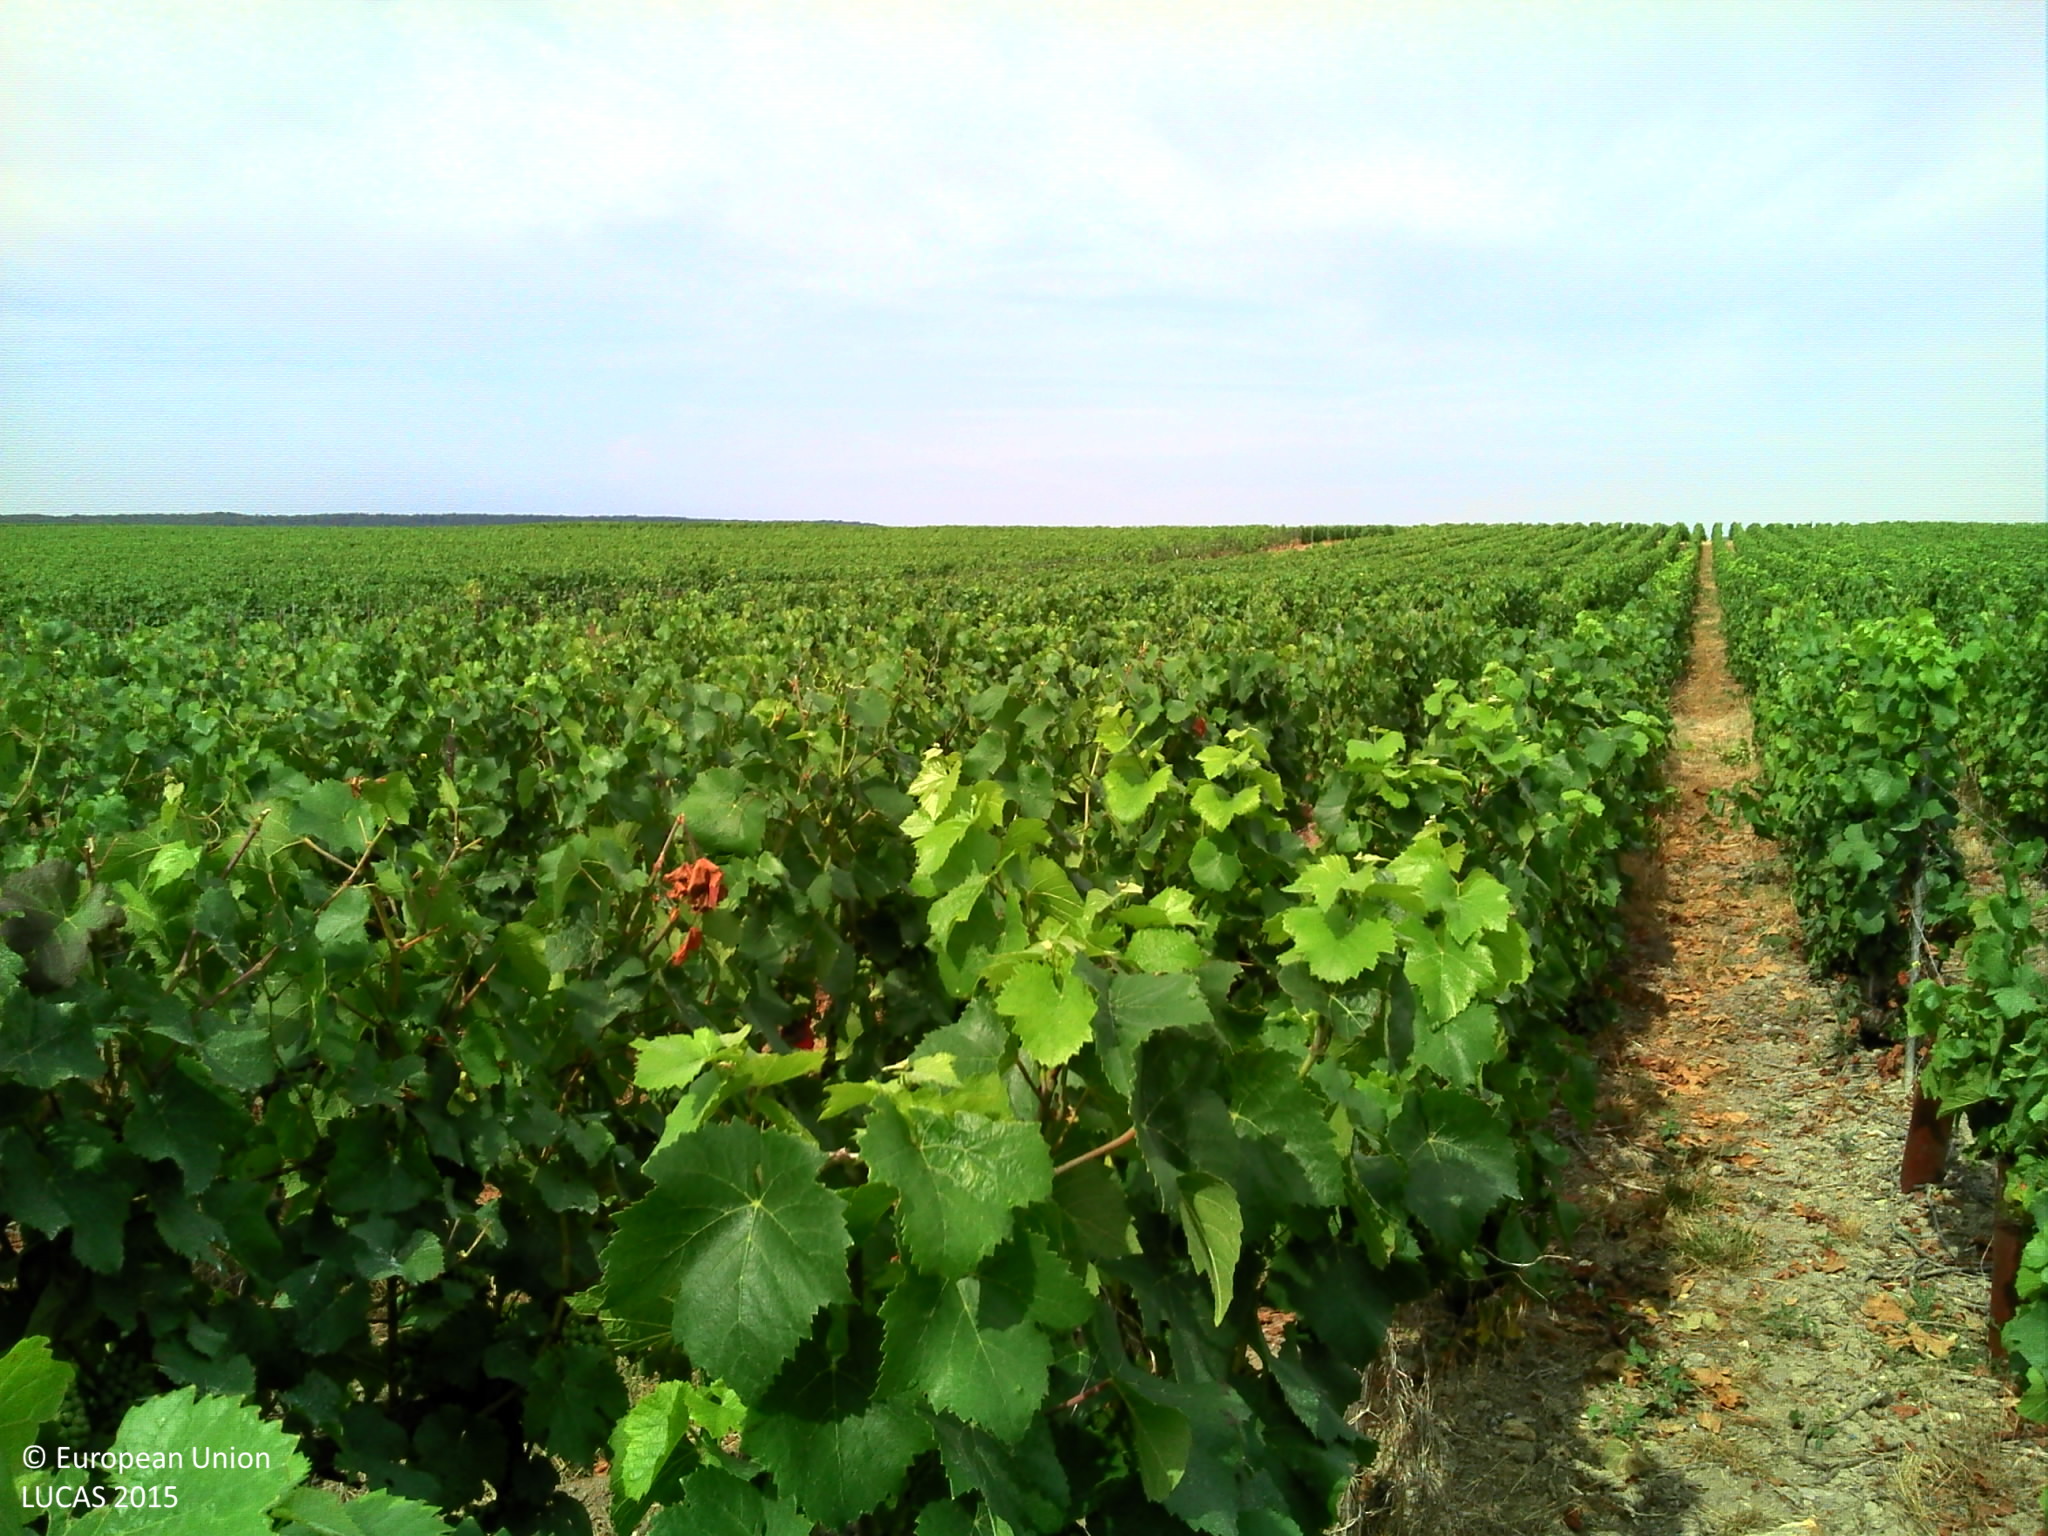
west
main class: Cropland
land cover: Vineyards
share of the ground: 50 - 75 %
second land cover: Other bare soil
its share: > 75 %
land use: Agriculture (excluding fallow land and kitchen gardens)
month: August
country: FR
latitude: 49.1665
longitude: 4.1117
